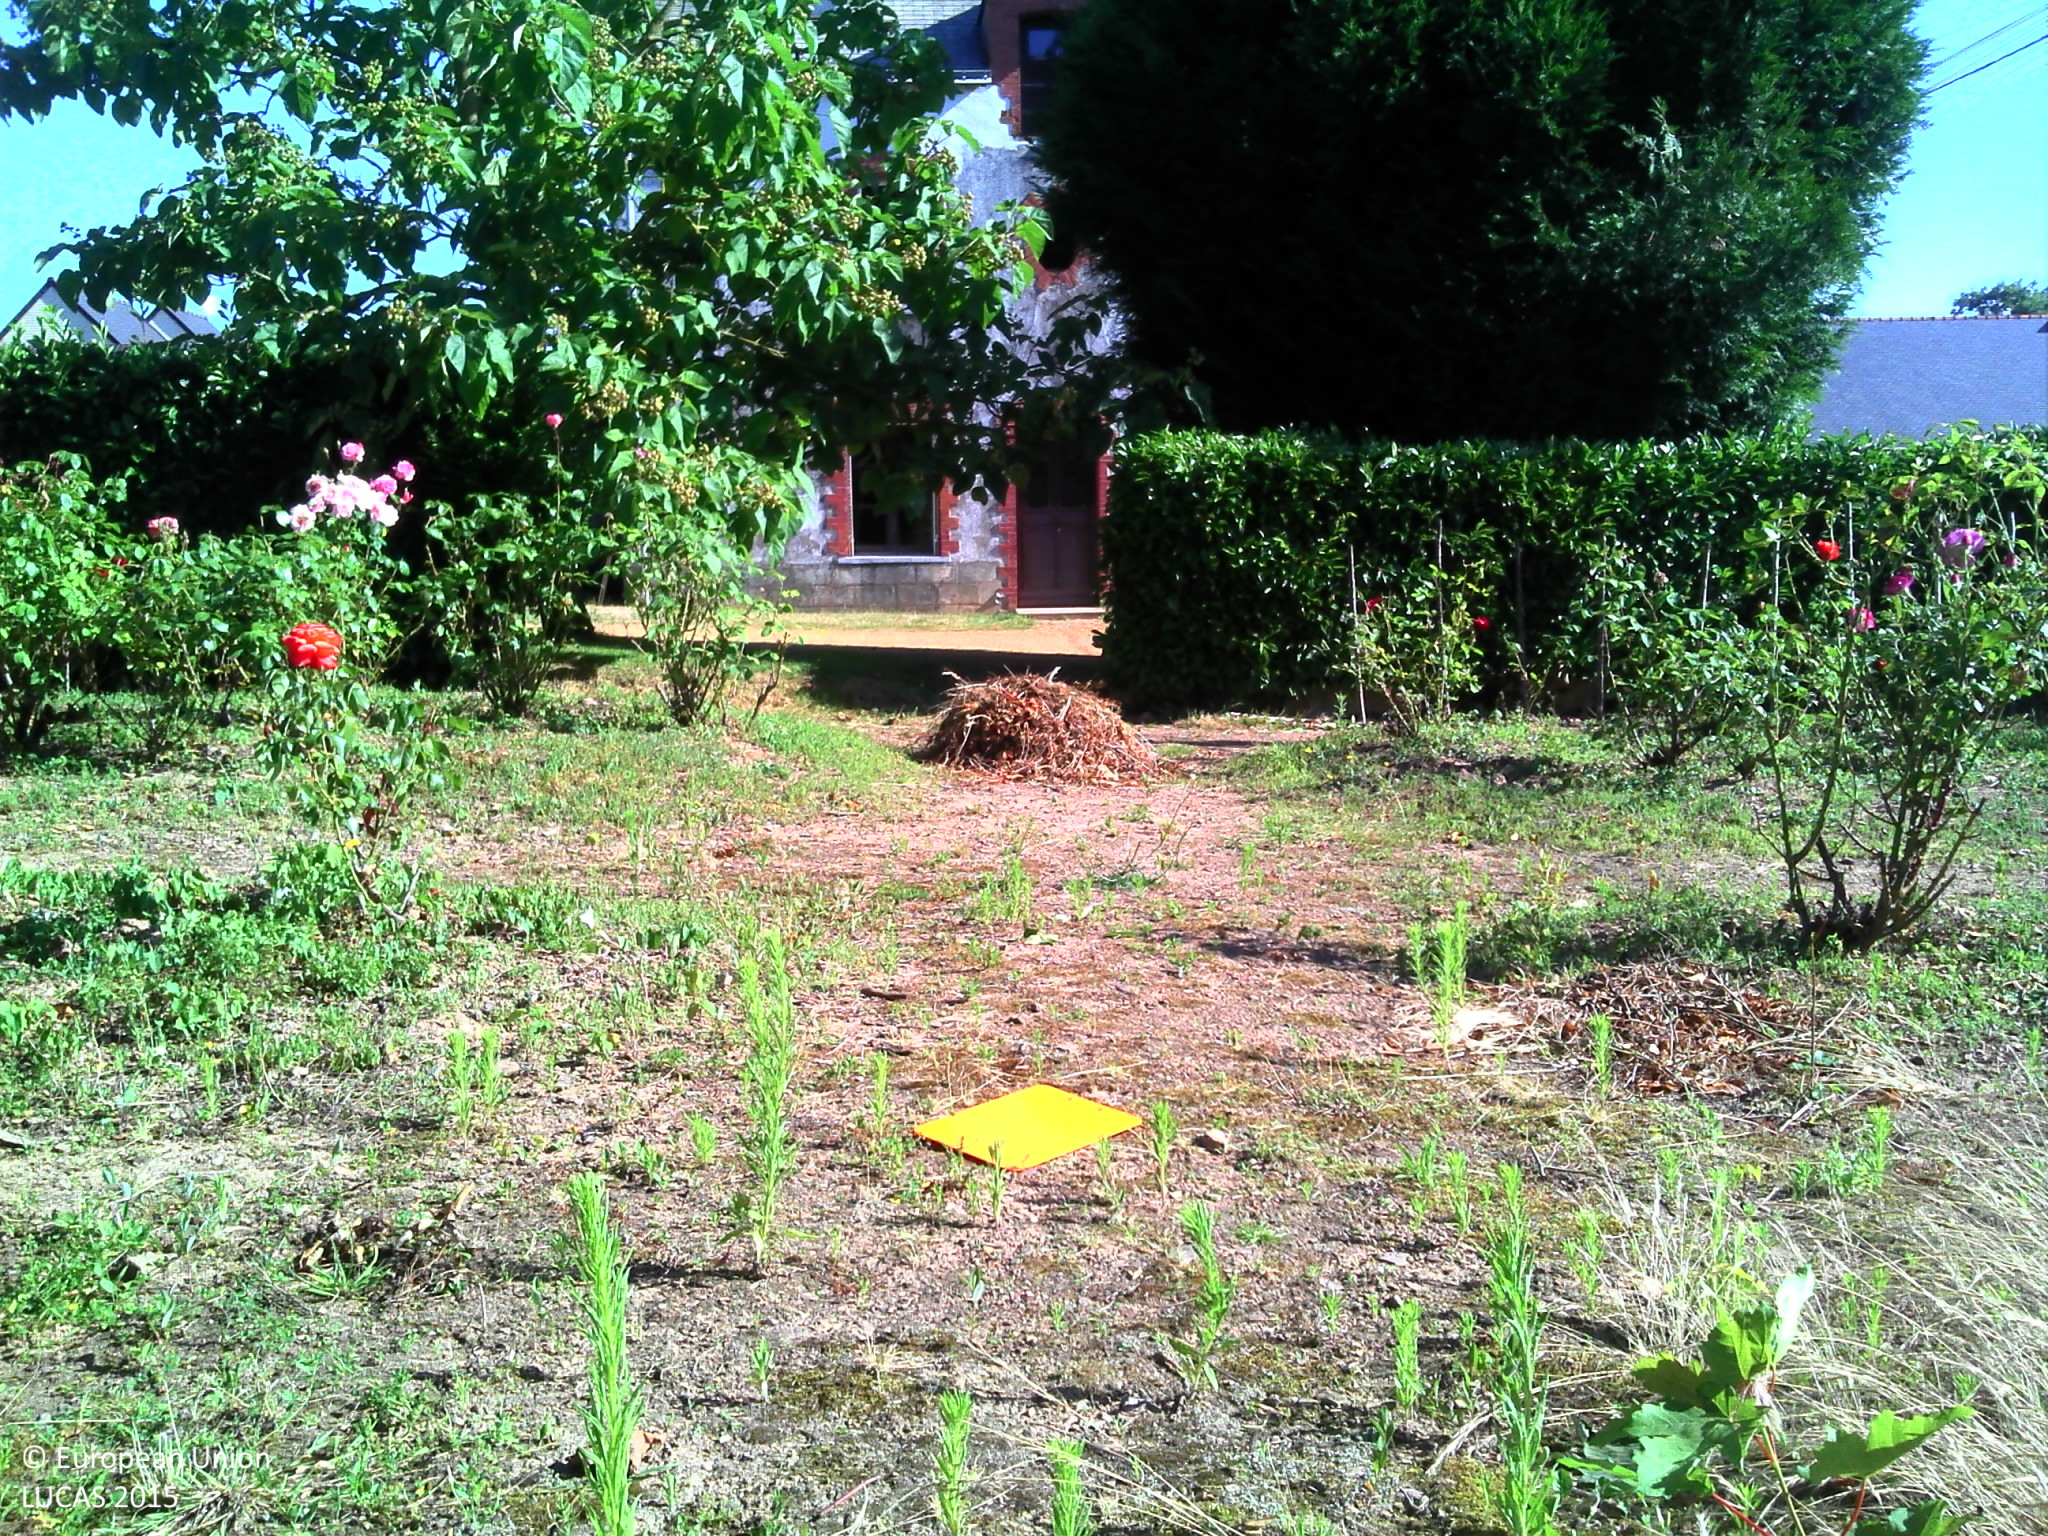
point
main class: Cropland
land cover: Floriculture and ornamental plants
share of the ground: < 10 %
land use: Kitchen garden
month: July
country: FR
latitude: 47.6570
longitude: -1.9937
